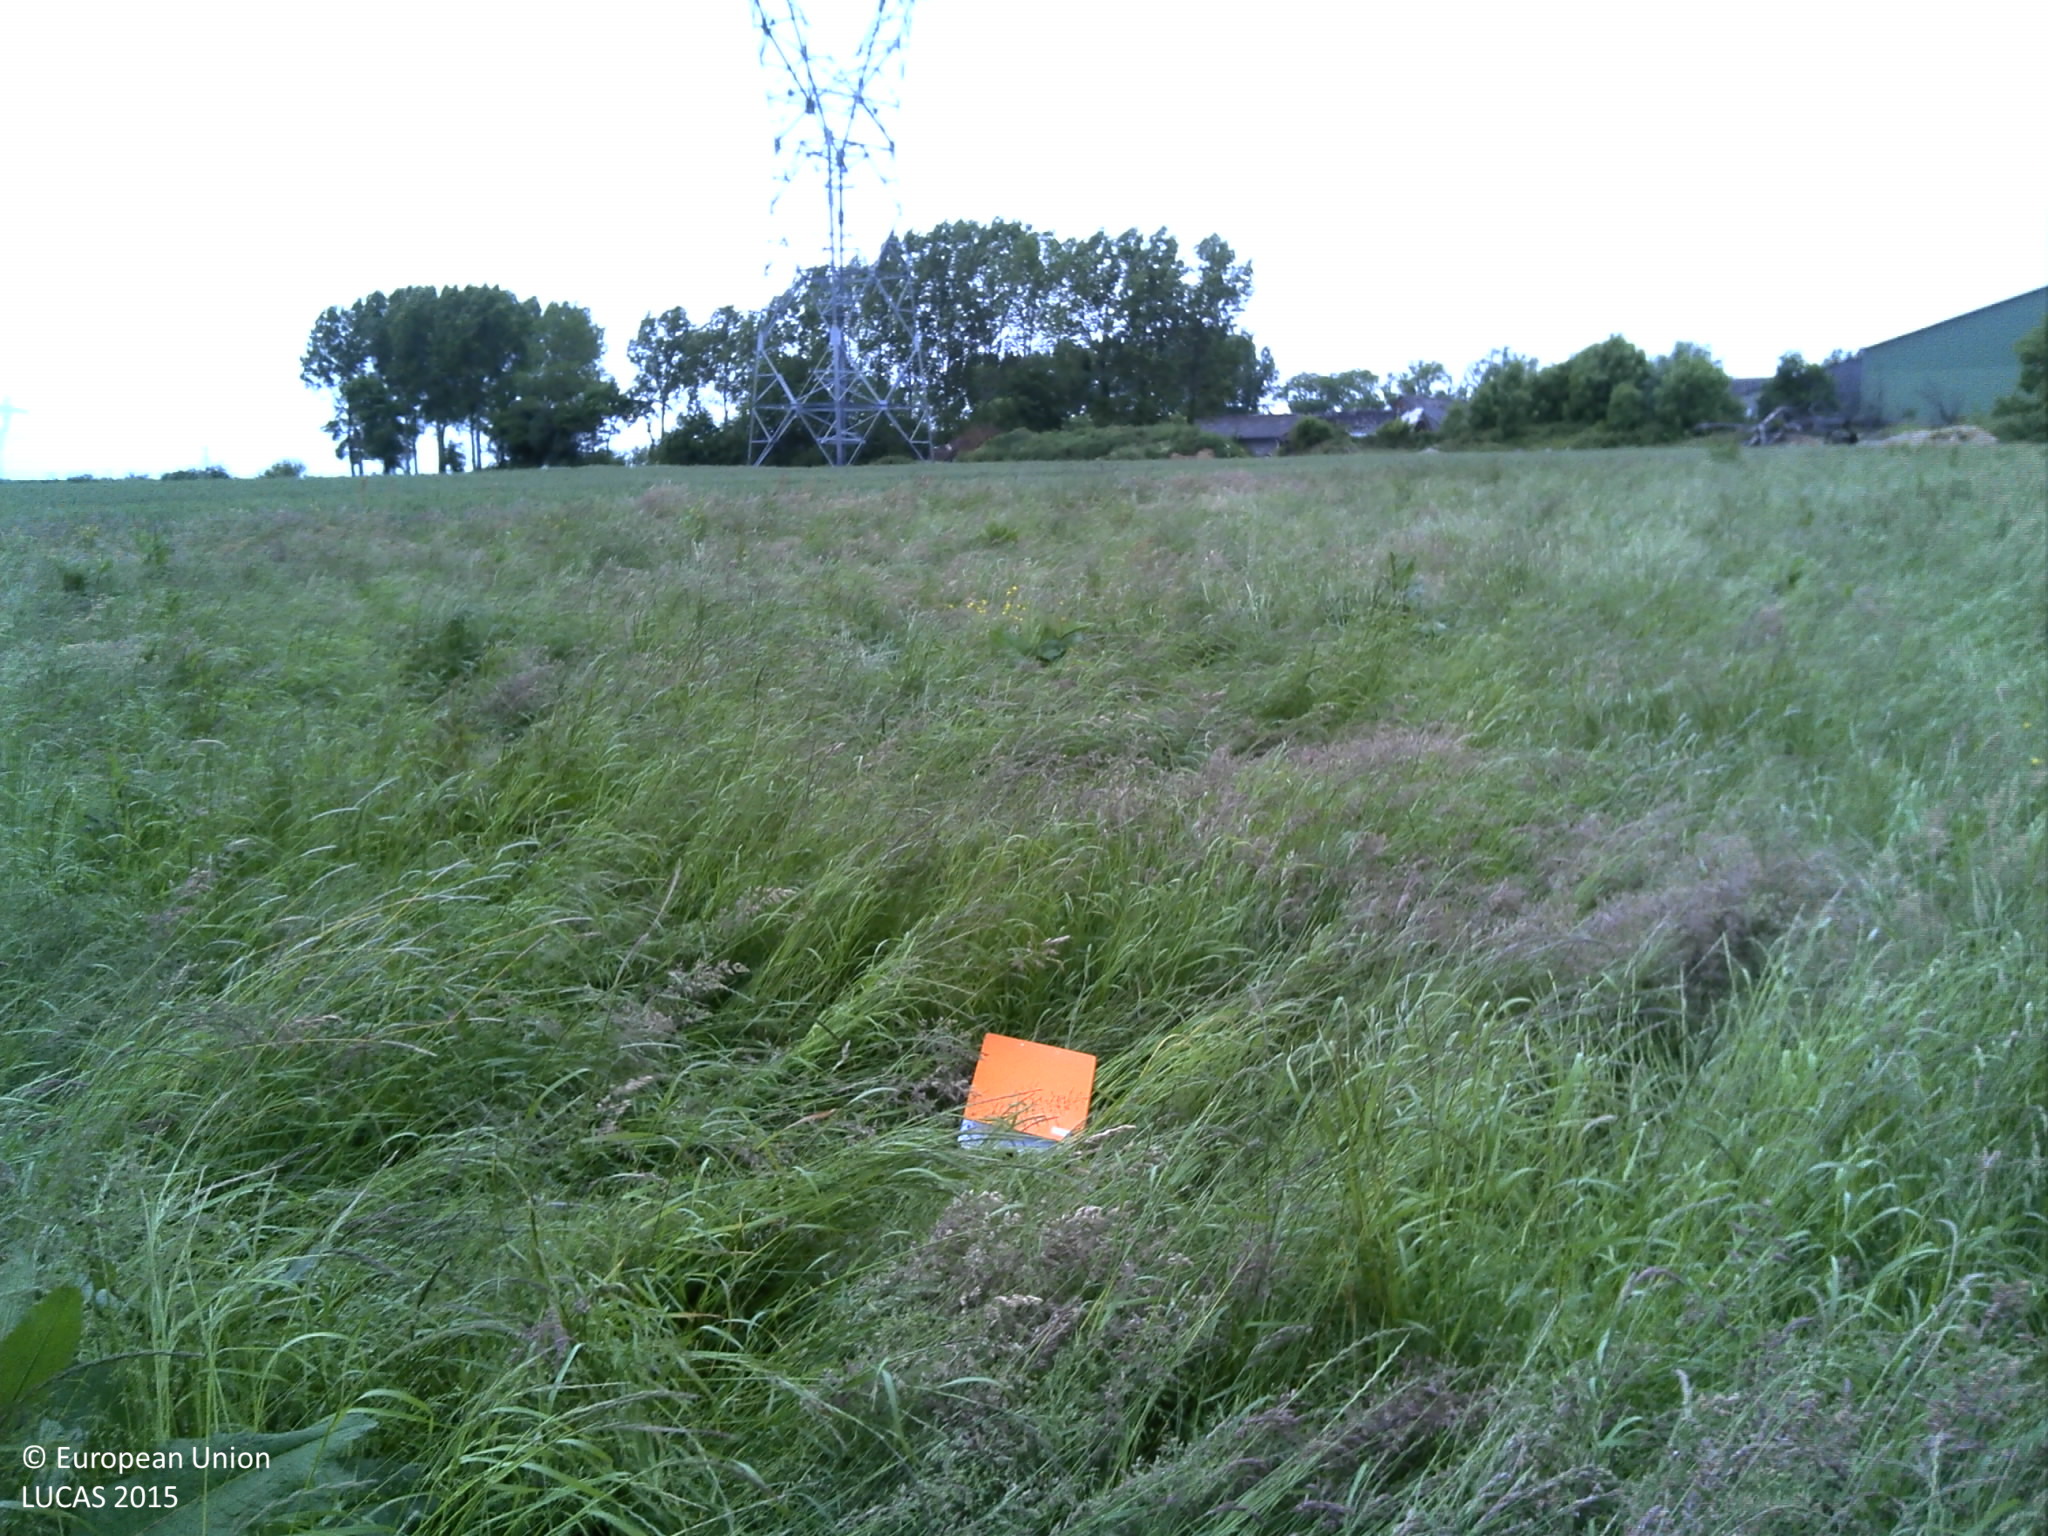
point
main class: Grassland
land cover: Grassland without tree/shrub cover
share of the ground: > 75 %
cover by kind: herbaceous plants 100 %
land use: Agriculture (excluding fallow land and kitchen gardens)
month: June
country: FR
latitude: 49.4832
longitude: 0.9917
